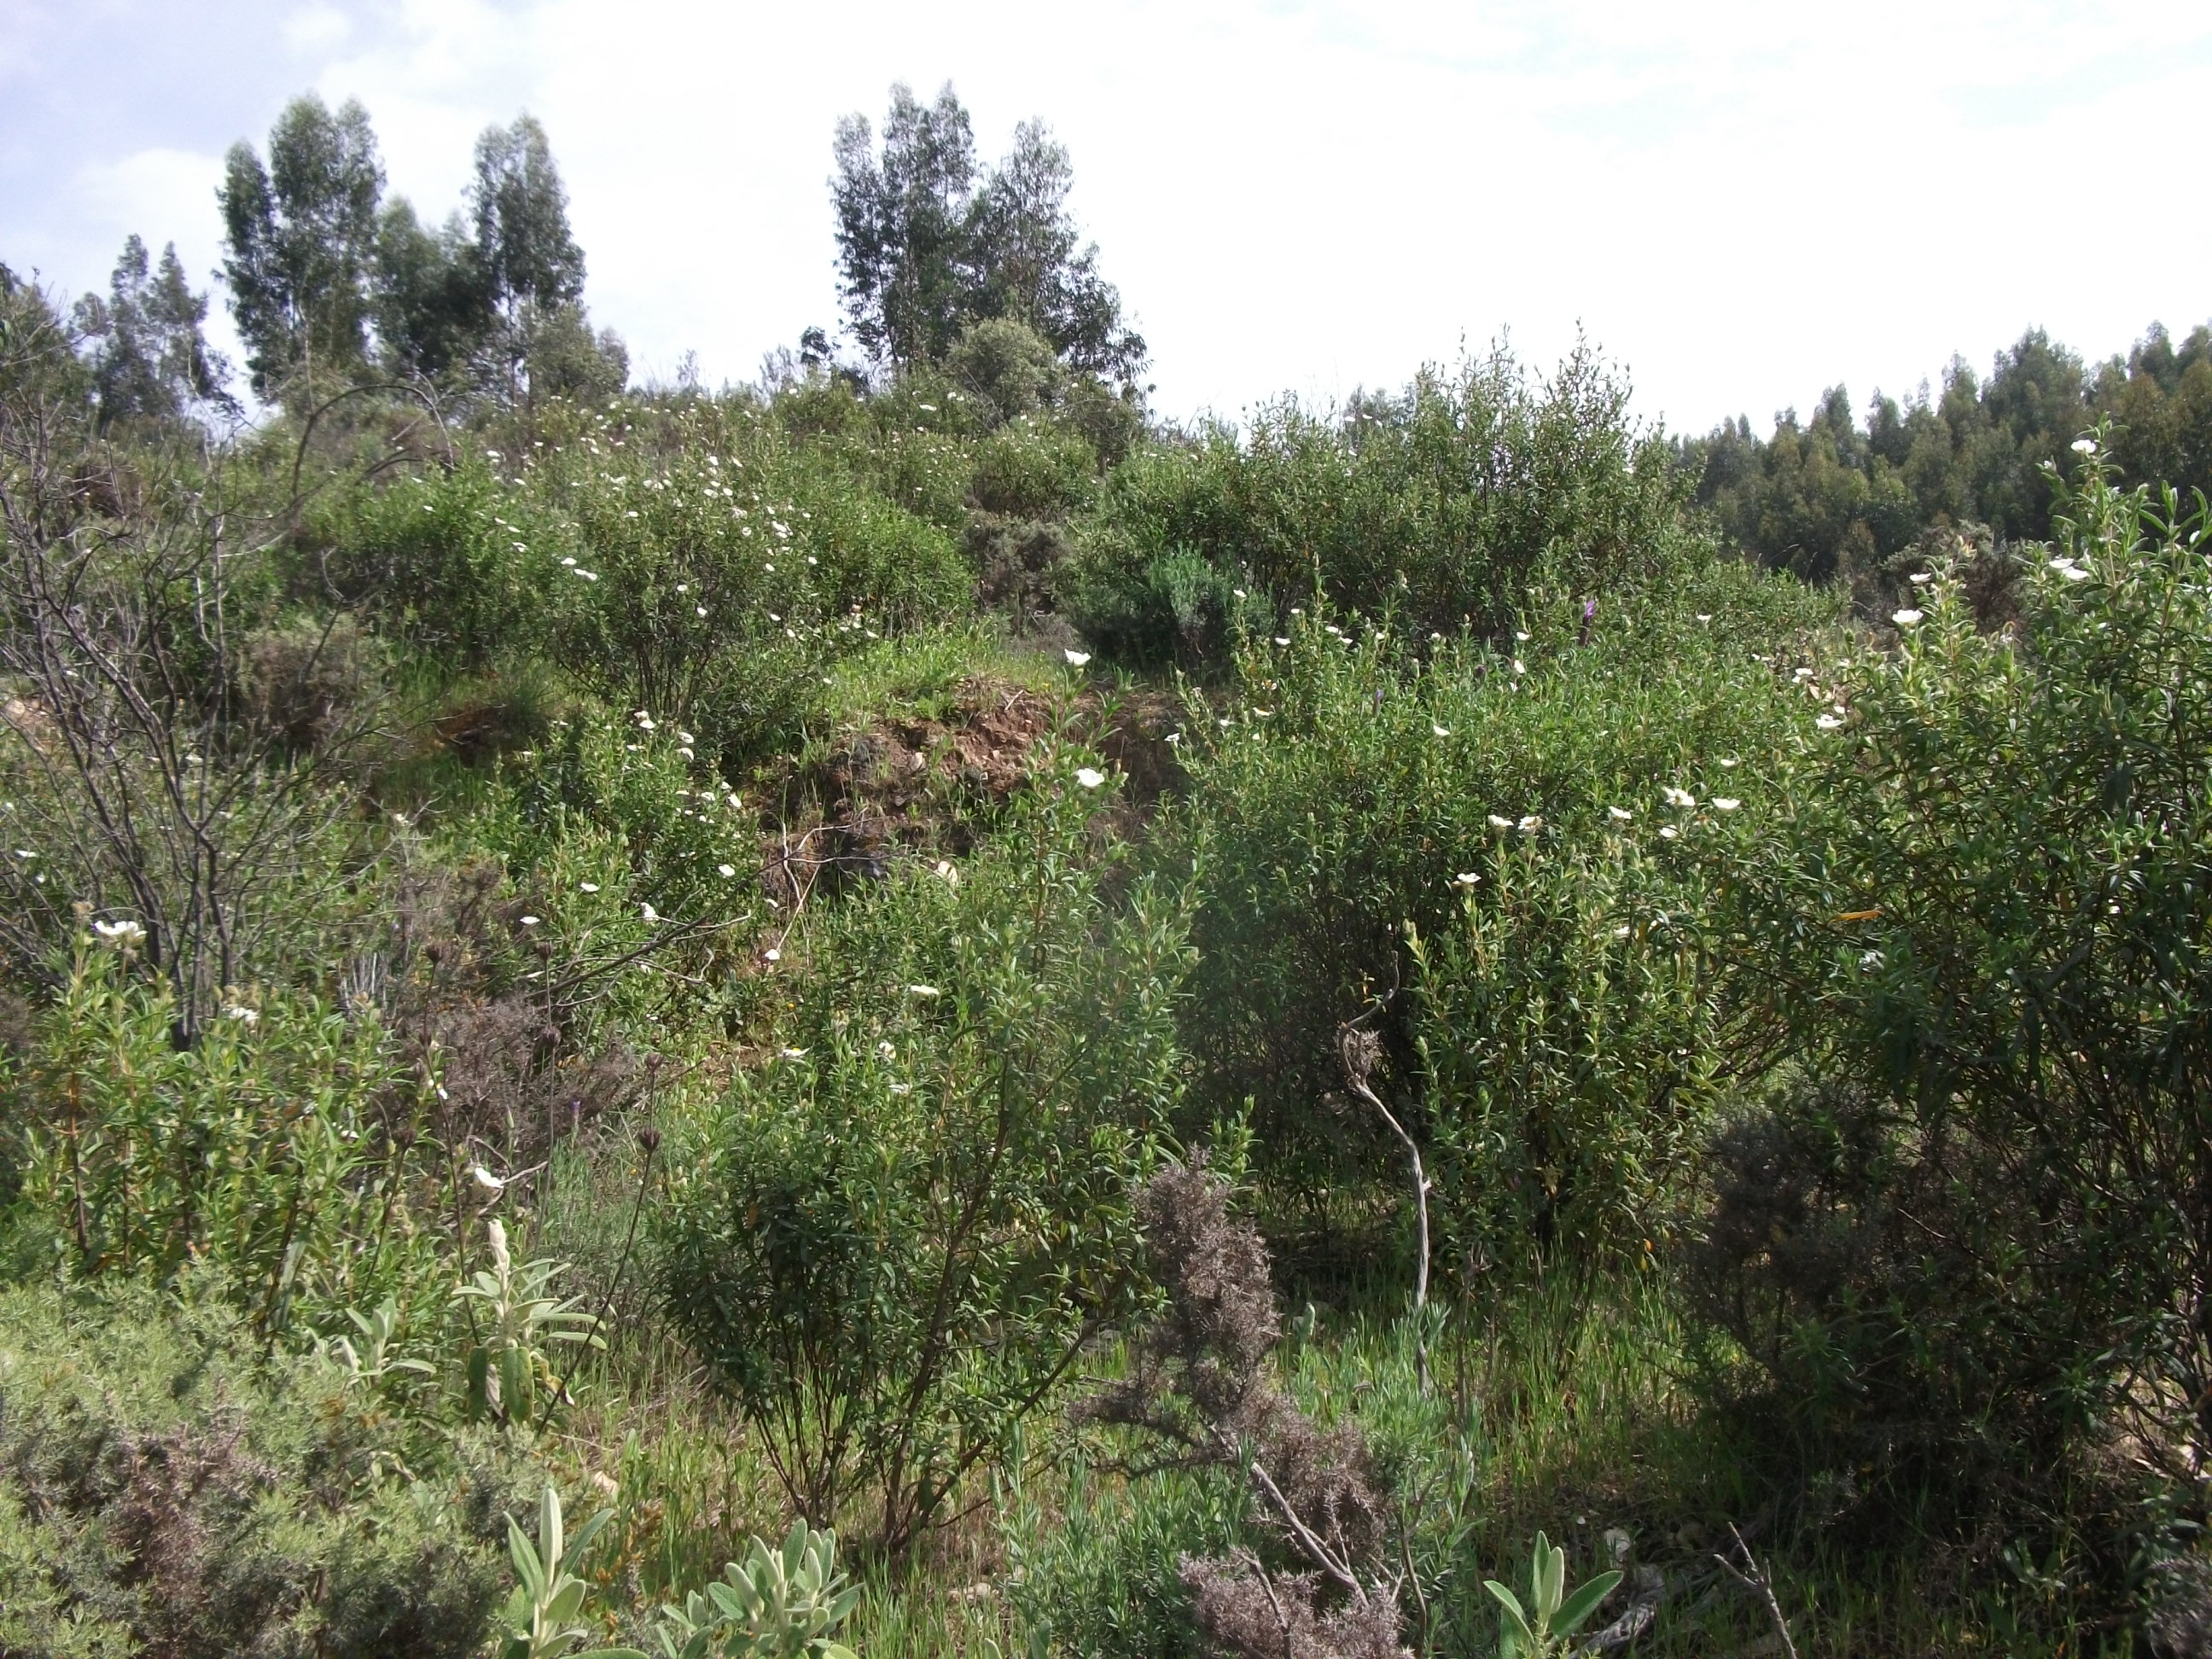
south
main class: Shrubland
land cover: Shrubland with sparse tree cover
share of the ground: > 75 %
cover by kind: shrubs 80 %, herbaceous plants 15 %, broadleaved forest trees 5 %
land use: Agriculture (excluding fallow land and kitchen gardens)
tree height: > 5 m
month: April
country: ES
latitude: 37.8049
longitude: -6.7296
